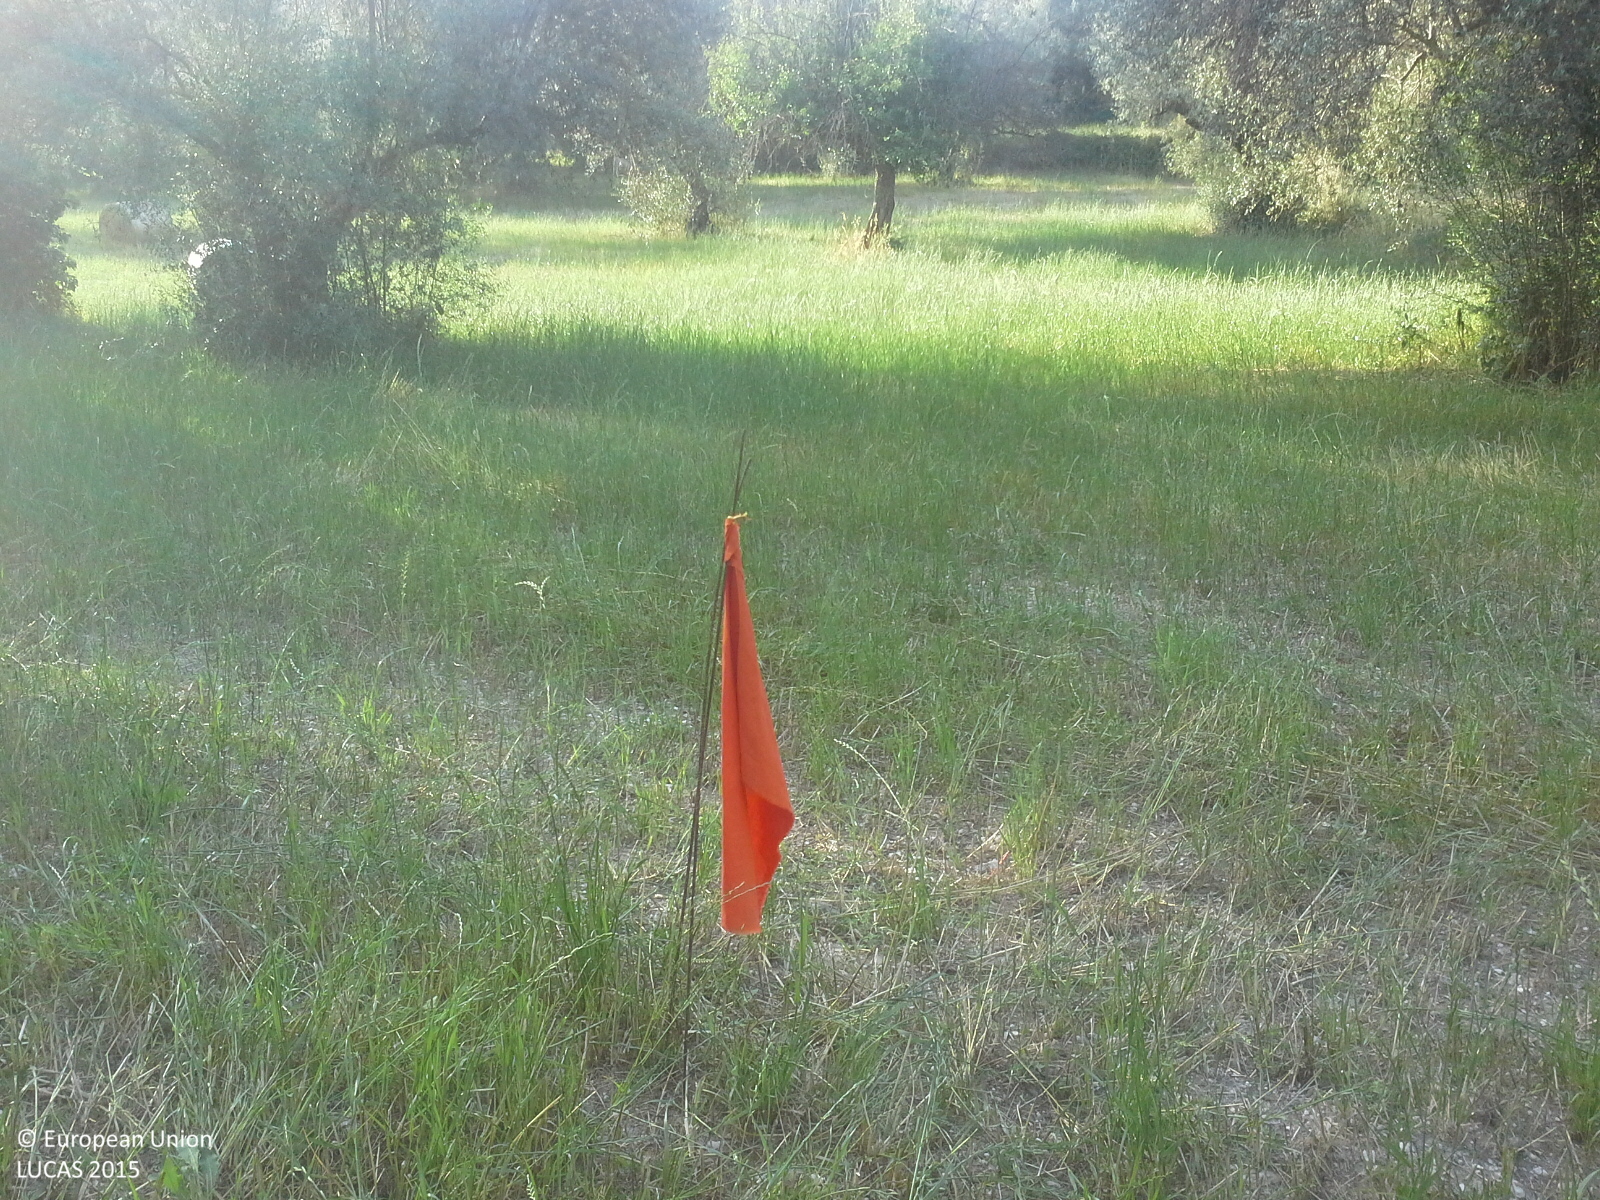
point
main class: Cropland
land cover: Olive groves
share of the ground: 50 - 75 %
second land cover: Mixed cereals for fodder
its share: > 75 %
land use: Agriculture (excluding fallow land and kitchen gardens)
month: June
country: IT
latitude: 36.9691
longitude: 14.8481
